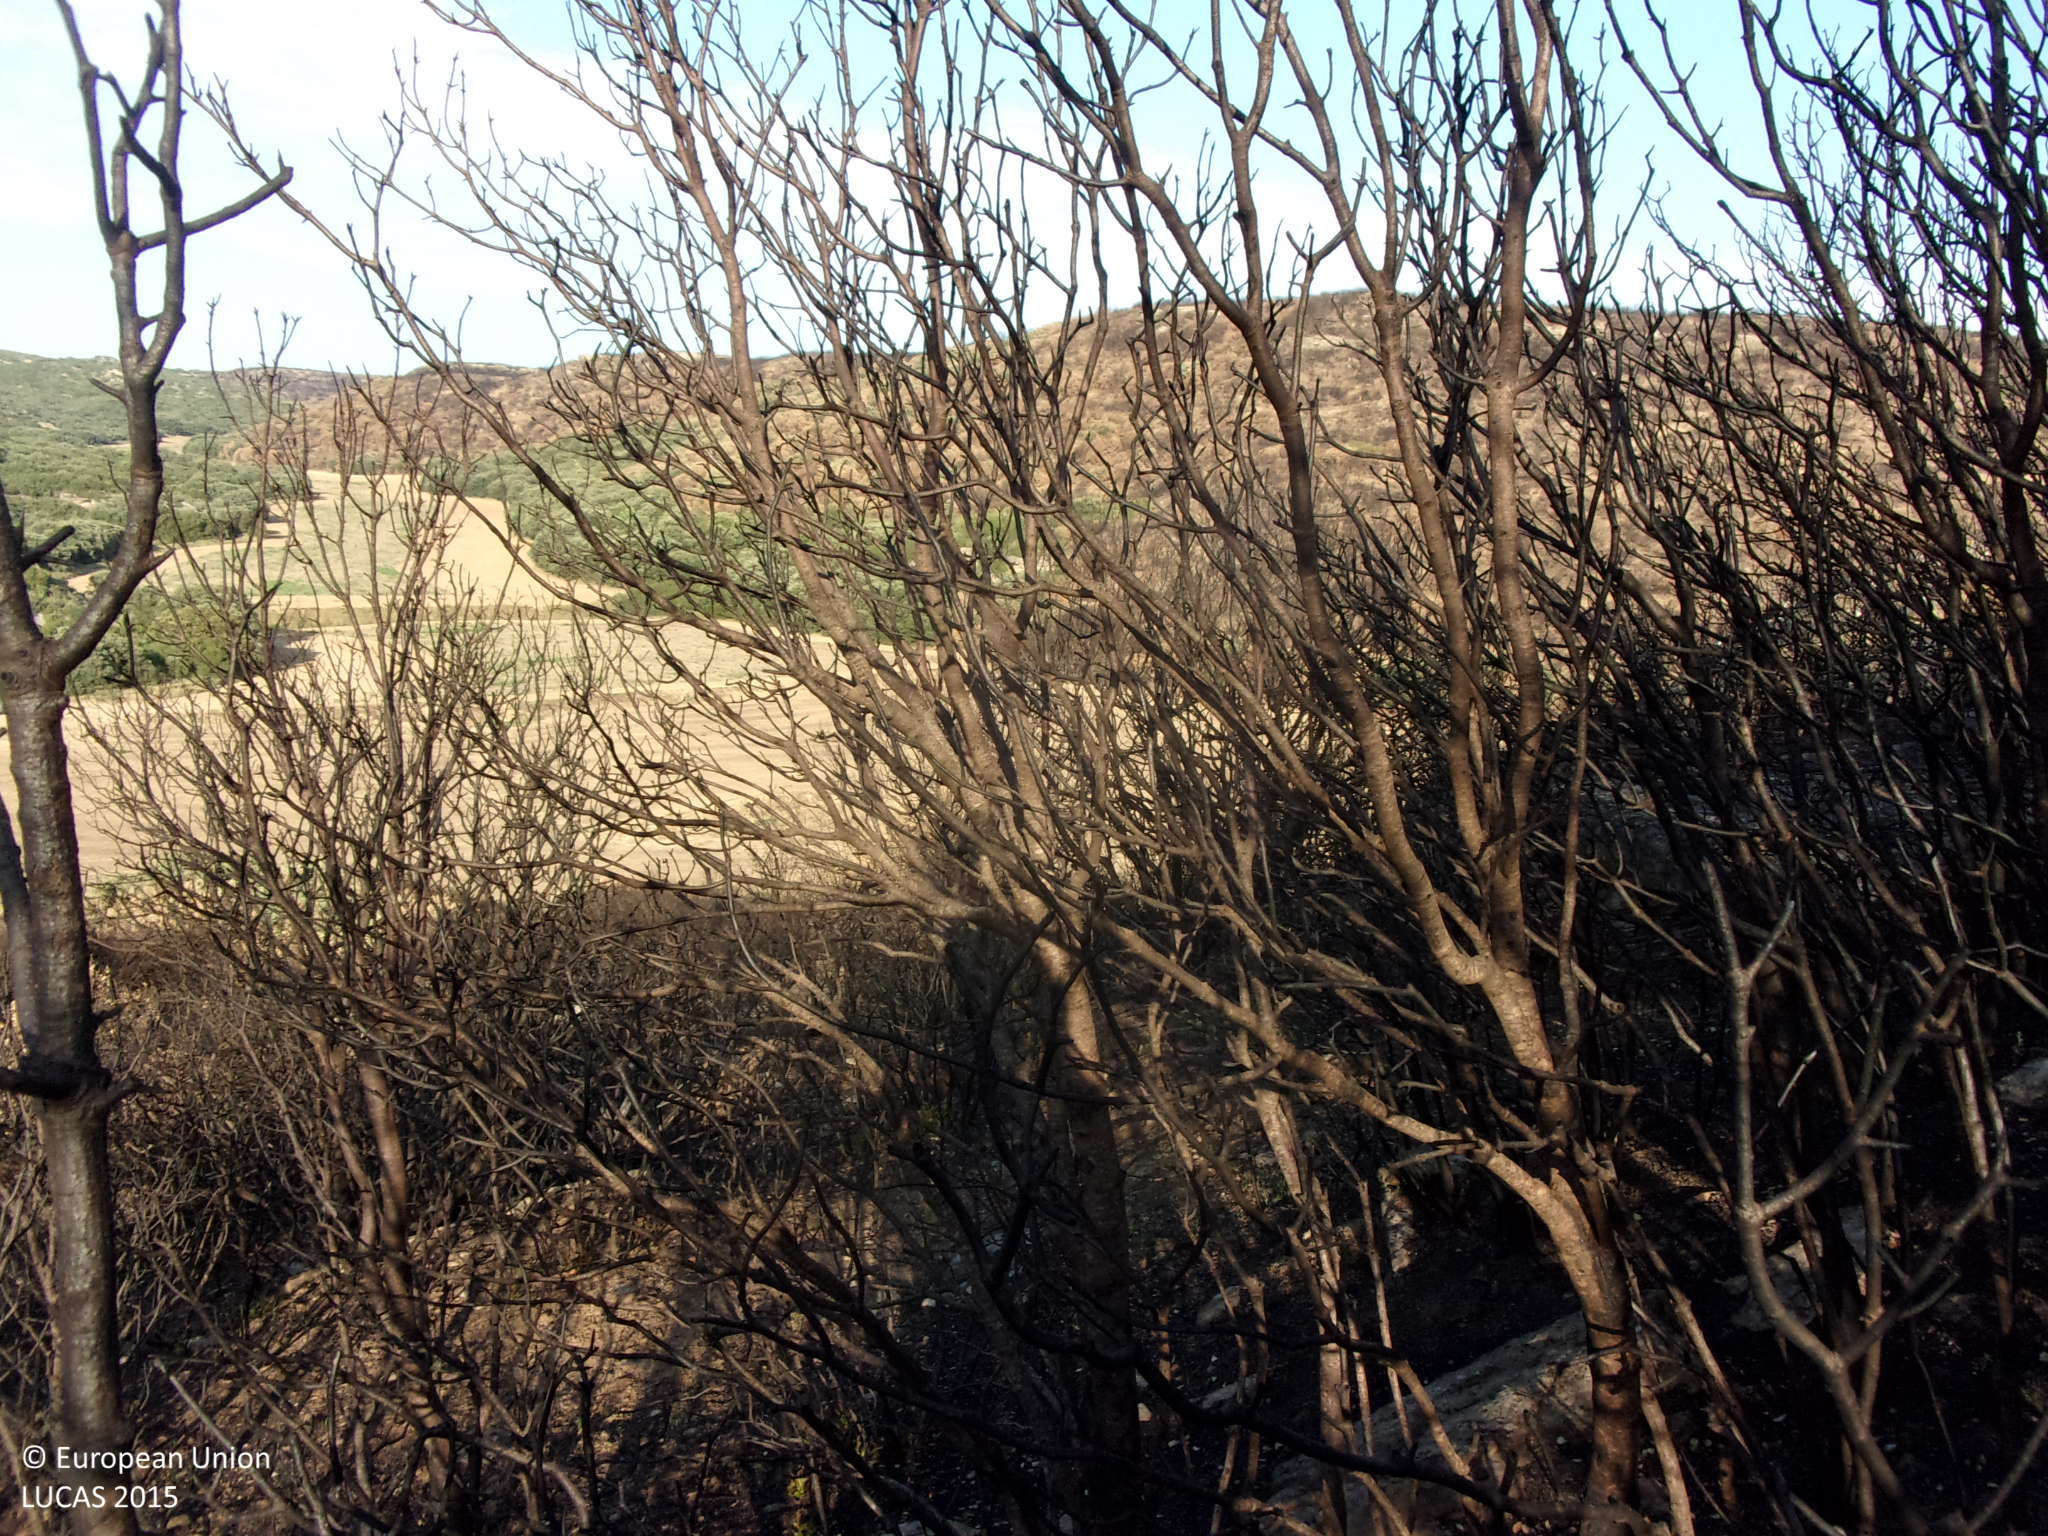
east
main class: Woodland
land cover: Broadleaved woodland
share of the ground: 10 - 25 %
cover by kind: unconsolidated bare surface 90 %, broadleaved forest trees 10 %
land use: Forestry
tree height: < 5 m
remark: Burnt area
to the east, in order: Broadleaved woodland; Tracks; Broadleaved woodland; Other bare soil; Grass margins; Other bare soil; Grass margins; Dry pulses; Broadleaved woodland
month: August
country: ES
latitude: 42.2966
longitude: -1.1034
